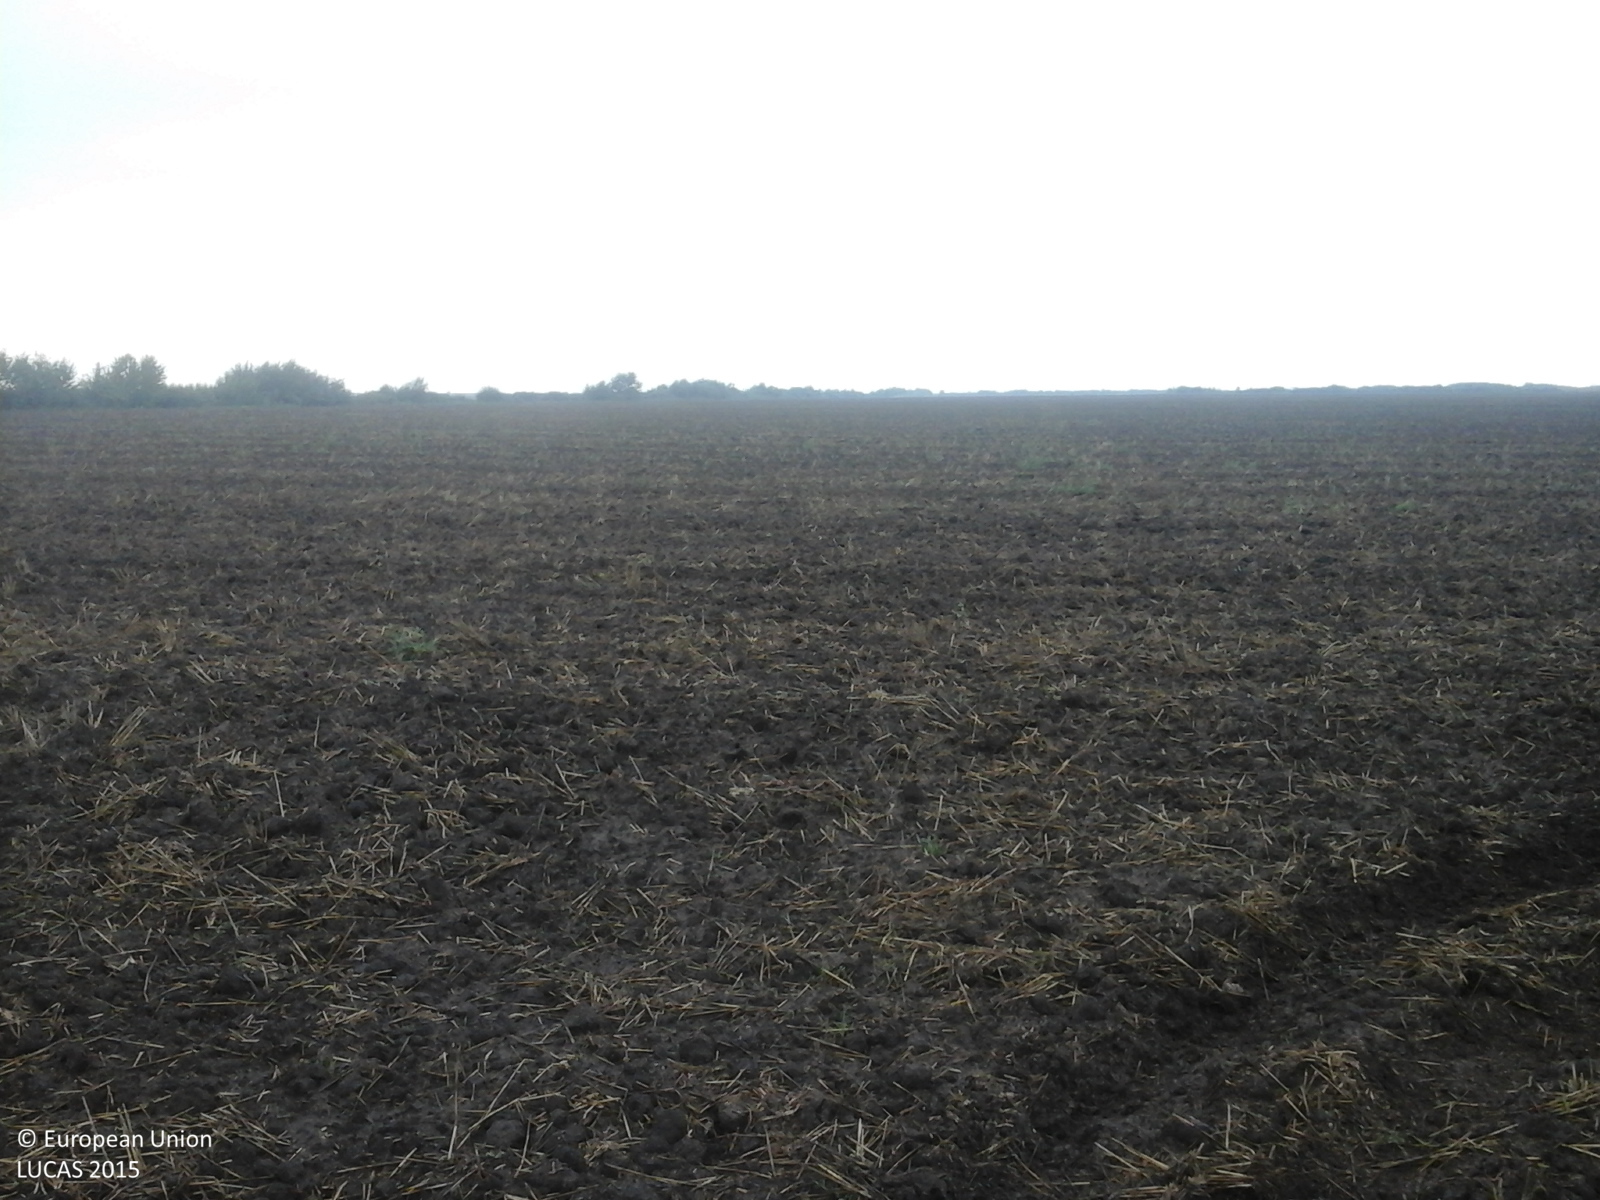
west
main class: Cropland
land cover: Common wheat
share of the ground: < 10 %
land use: Agriculture (excluding fallow land and kitchen gardens)
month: August
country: RO
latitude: 45.6006
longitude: 21.1701
